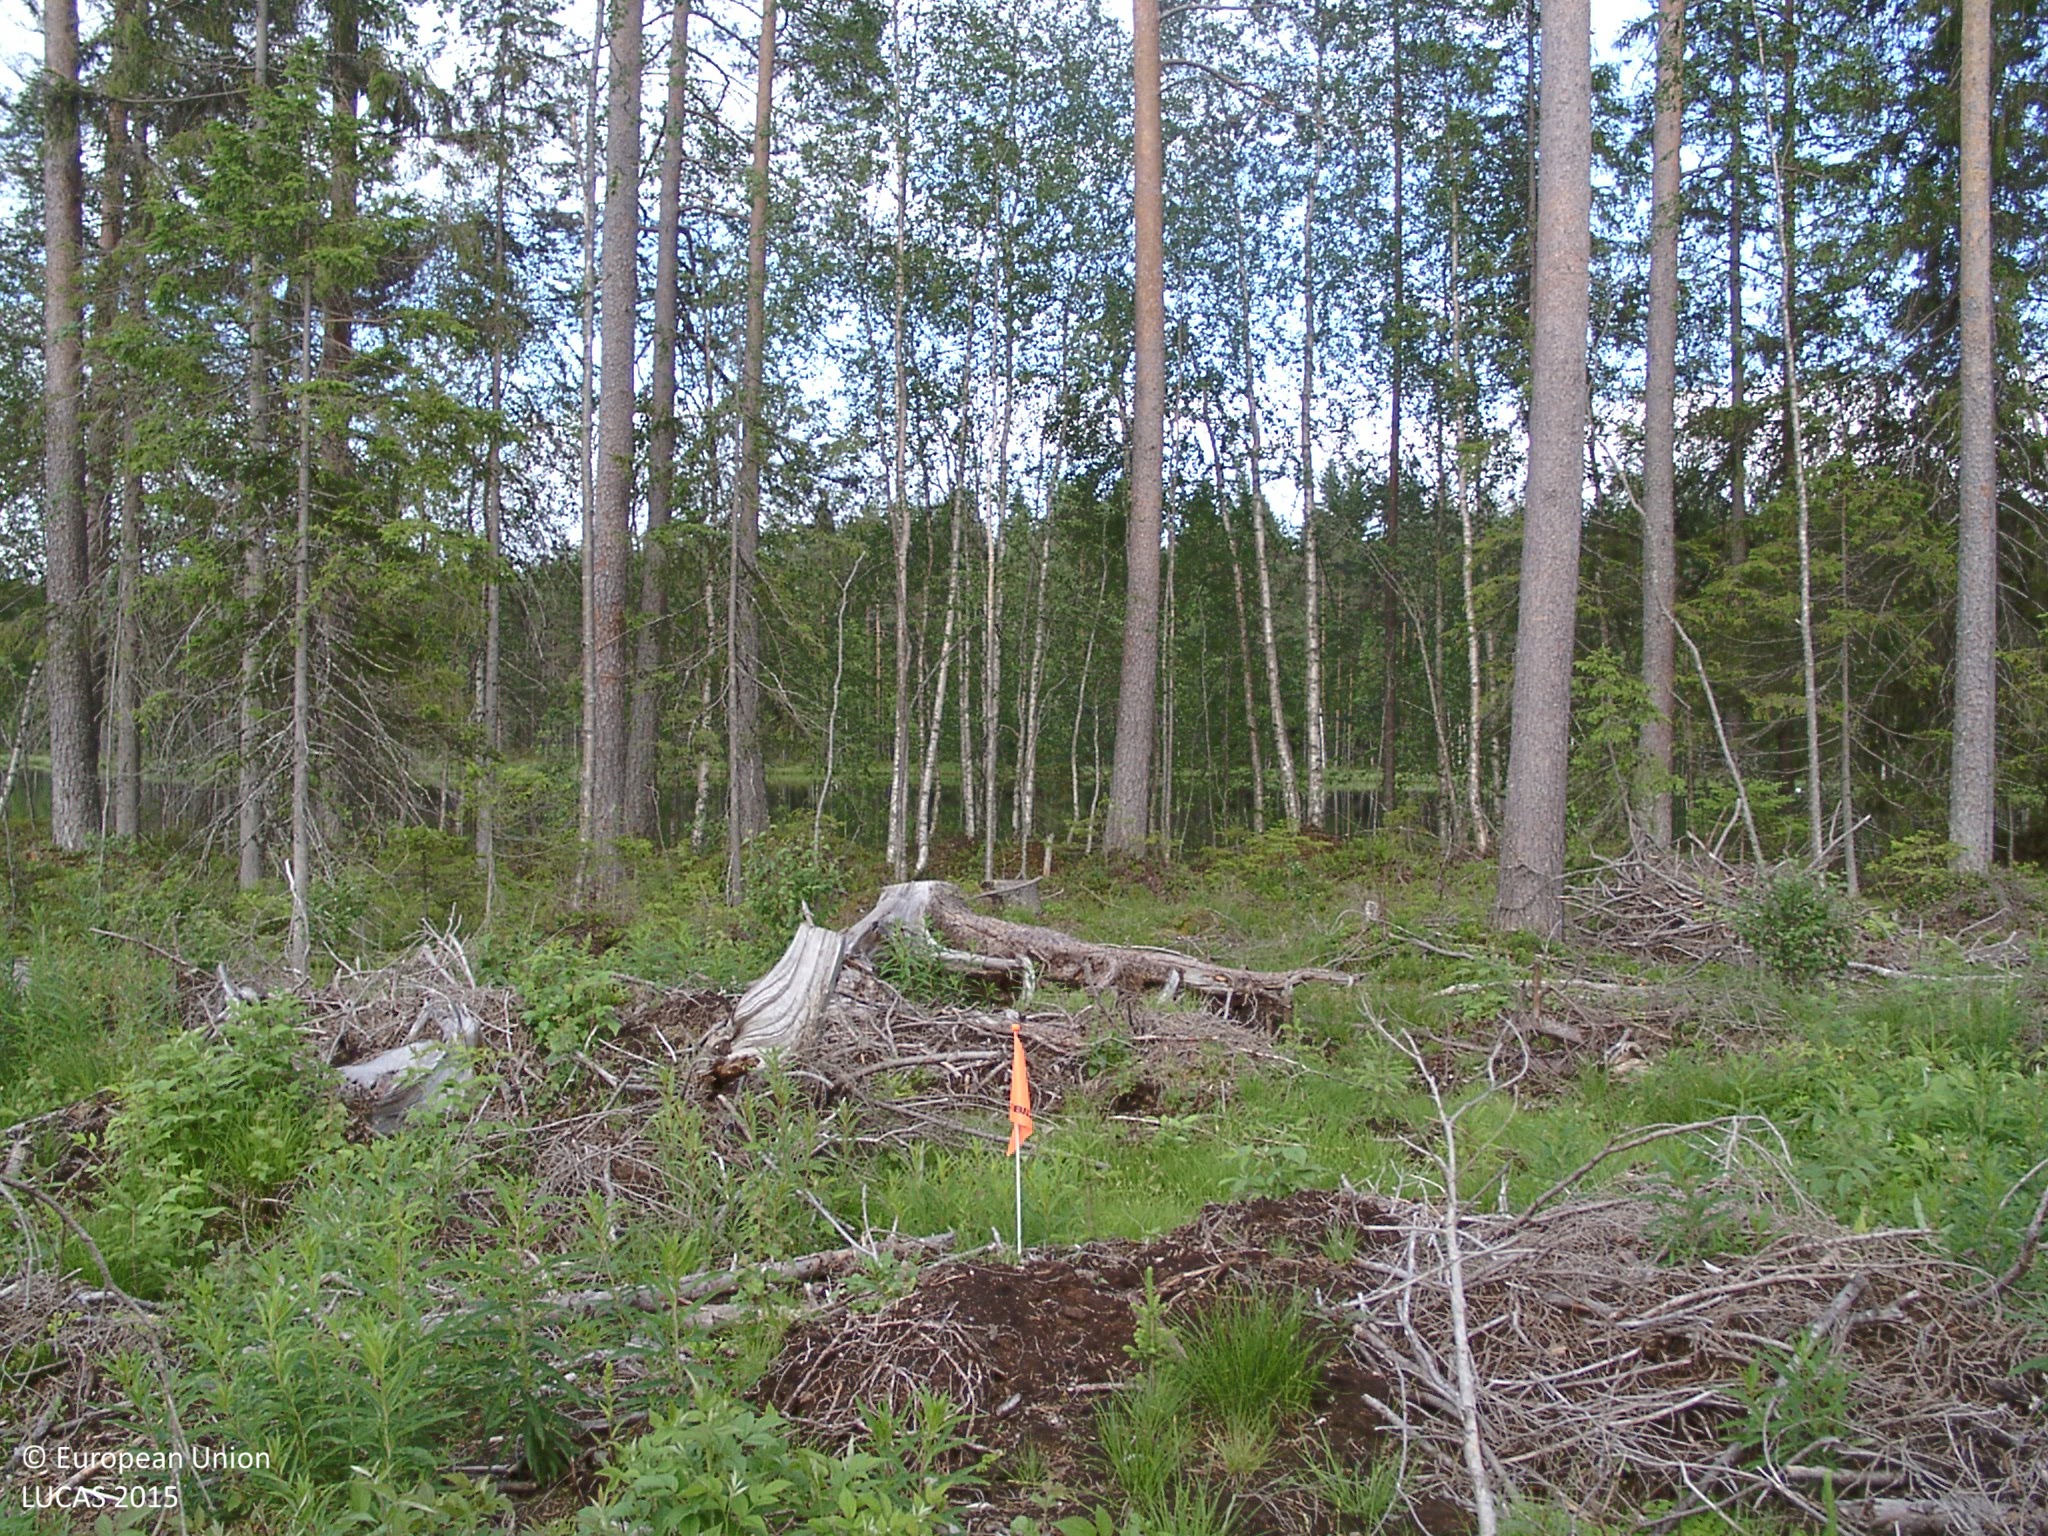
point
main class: Shrubland
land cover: Shrubland with sparse tree cover
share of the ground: 10 - 25 %
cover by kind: herbaceous plants 40 %, shrubs 15 %, broadleaved forest trees 5 %, unconsolidated bare surface 5 %
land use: Forestry
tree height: < 5 m
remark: Nursery
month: July
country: FI
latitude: 62.0783
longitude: 25.3304
